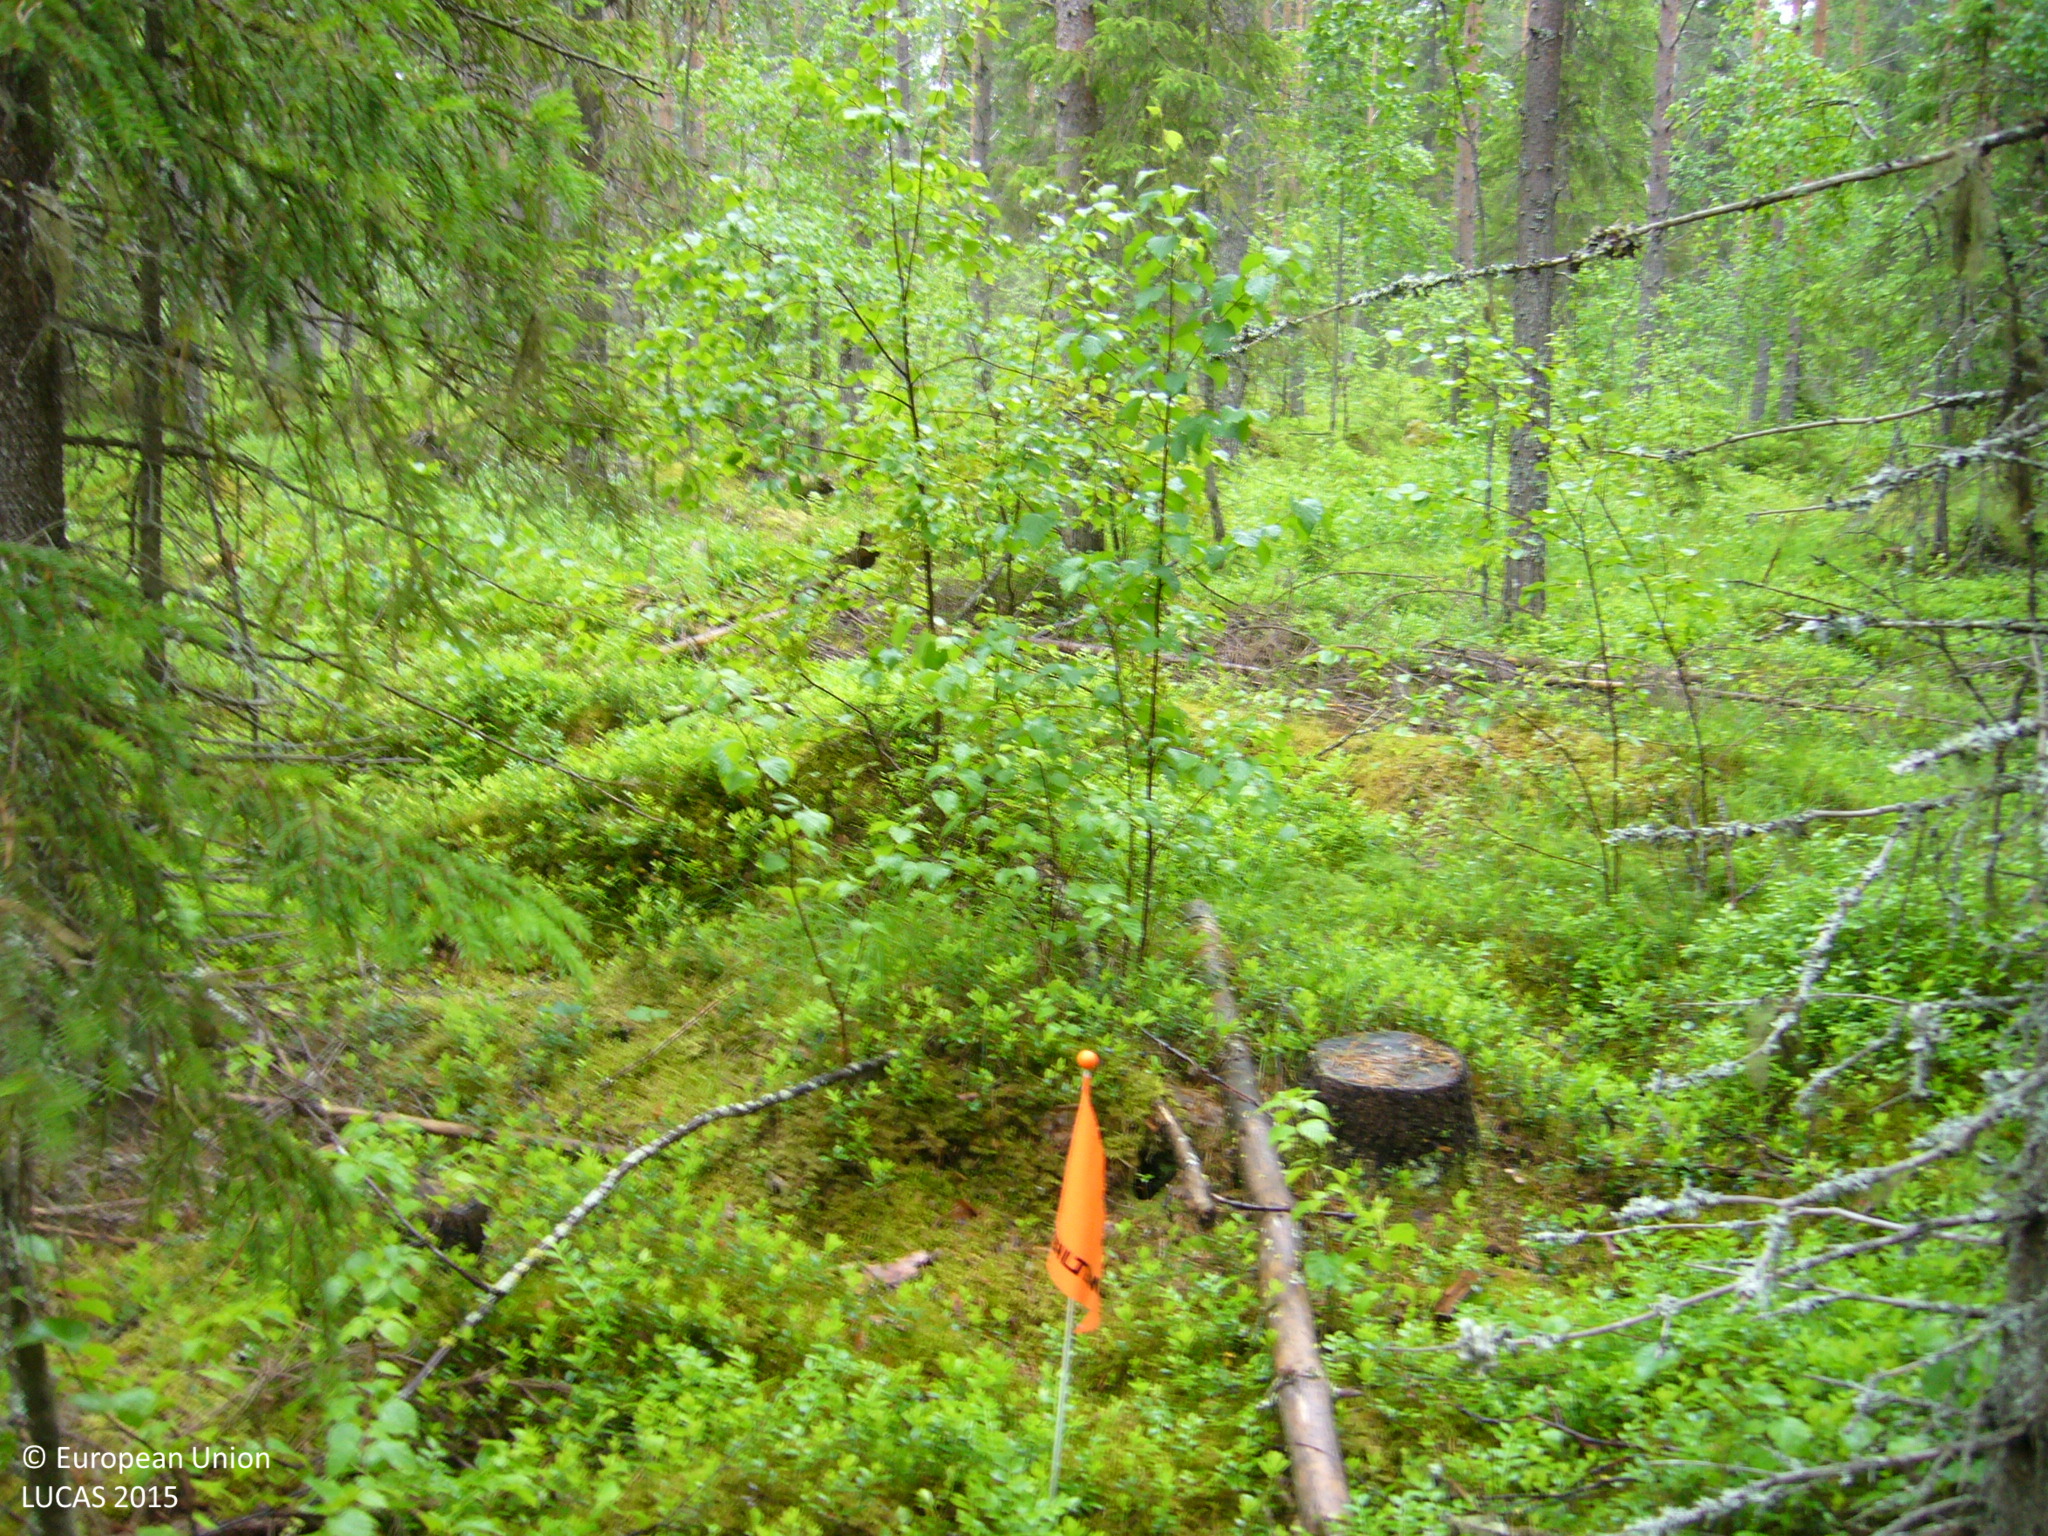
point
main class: Woodland
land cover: Spruce dominated coniferous woodland
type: boreal forest
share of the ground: > 75 %
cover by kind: coniferous forest trees 65 %, shrubs 25 %, broadleaved forest trees 10 %
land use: Forestry
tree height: > 5 m
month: July
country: FI
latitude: 63.4666
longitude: 26.3552
